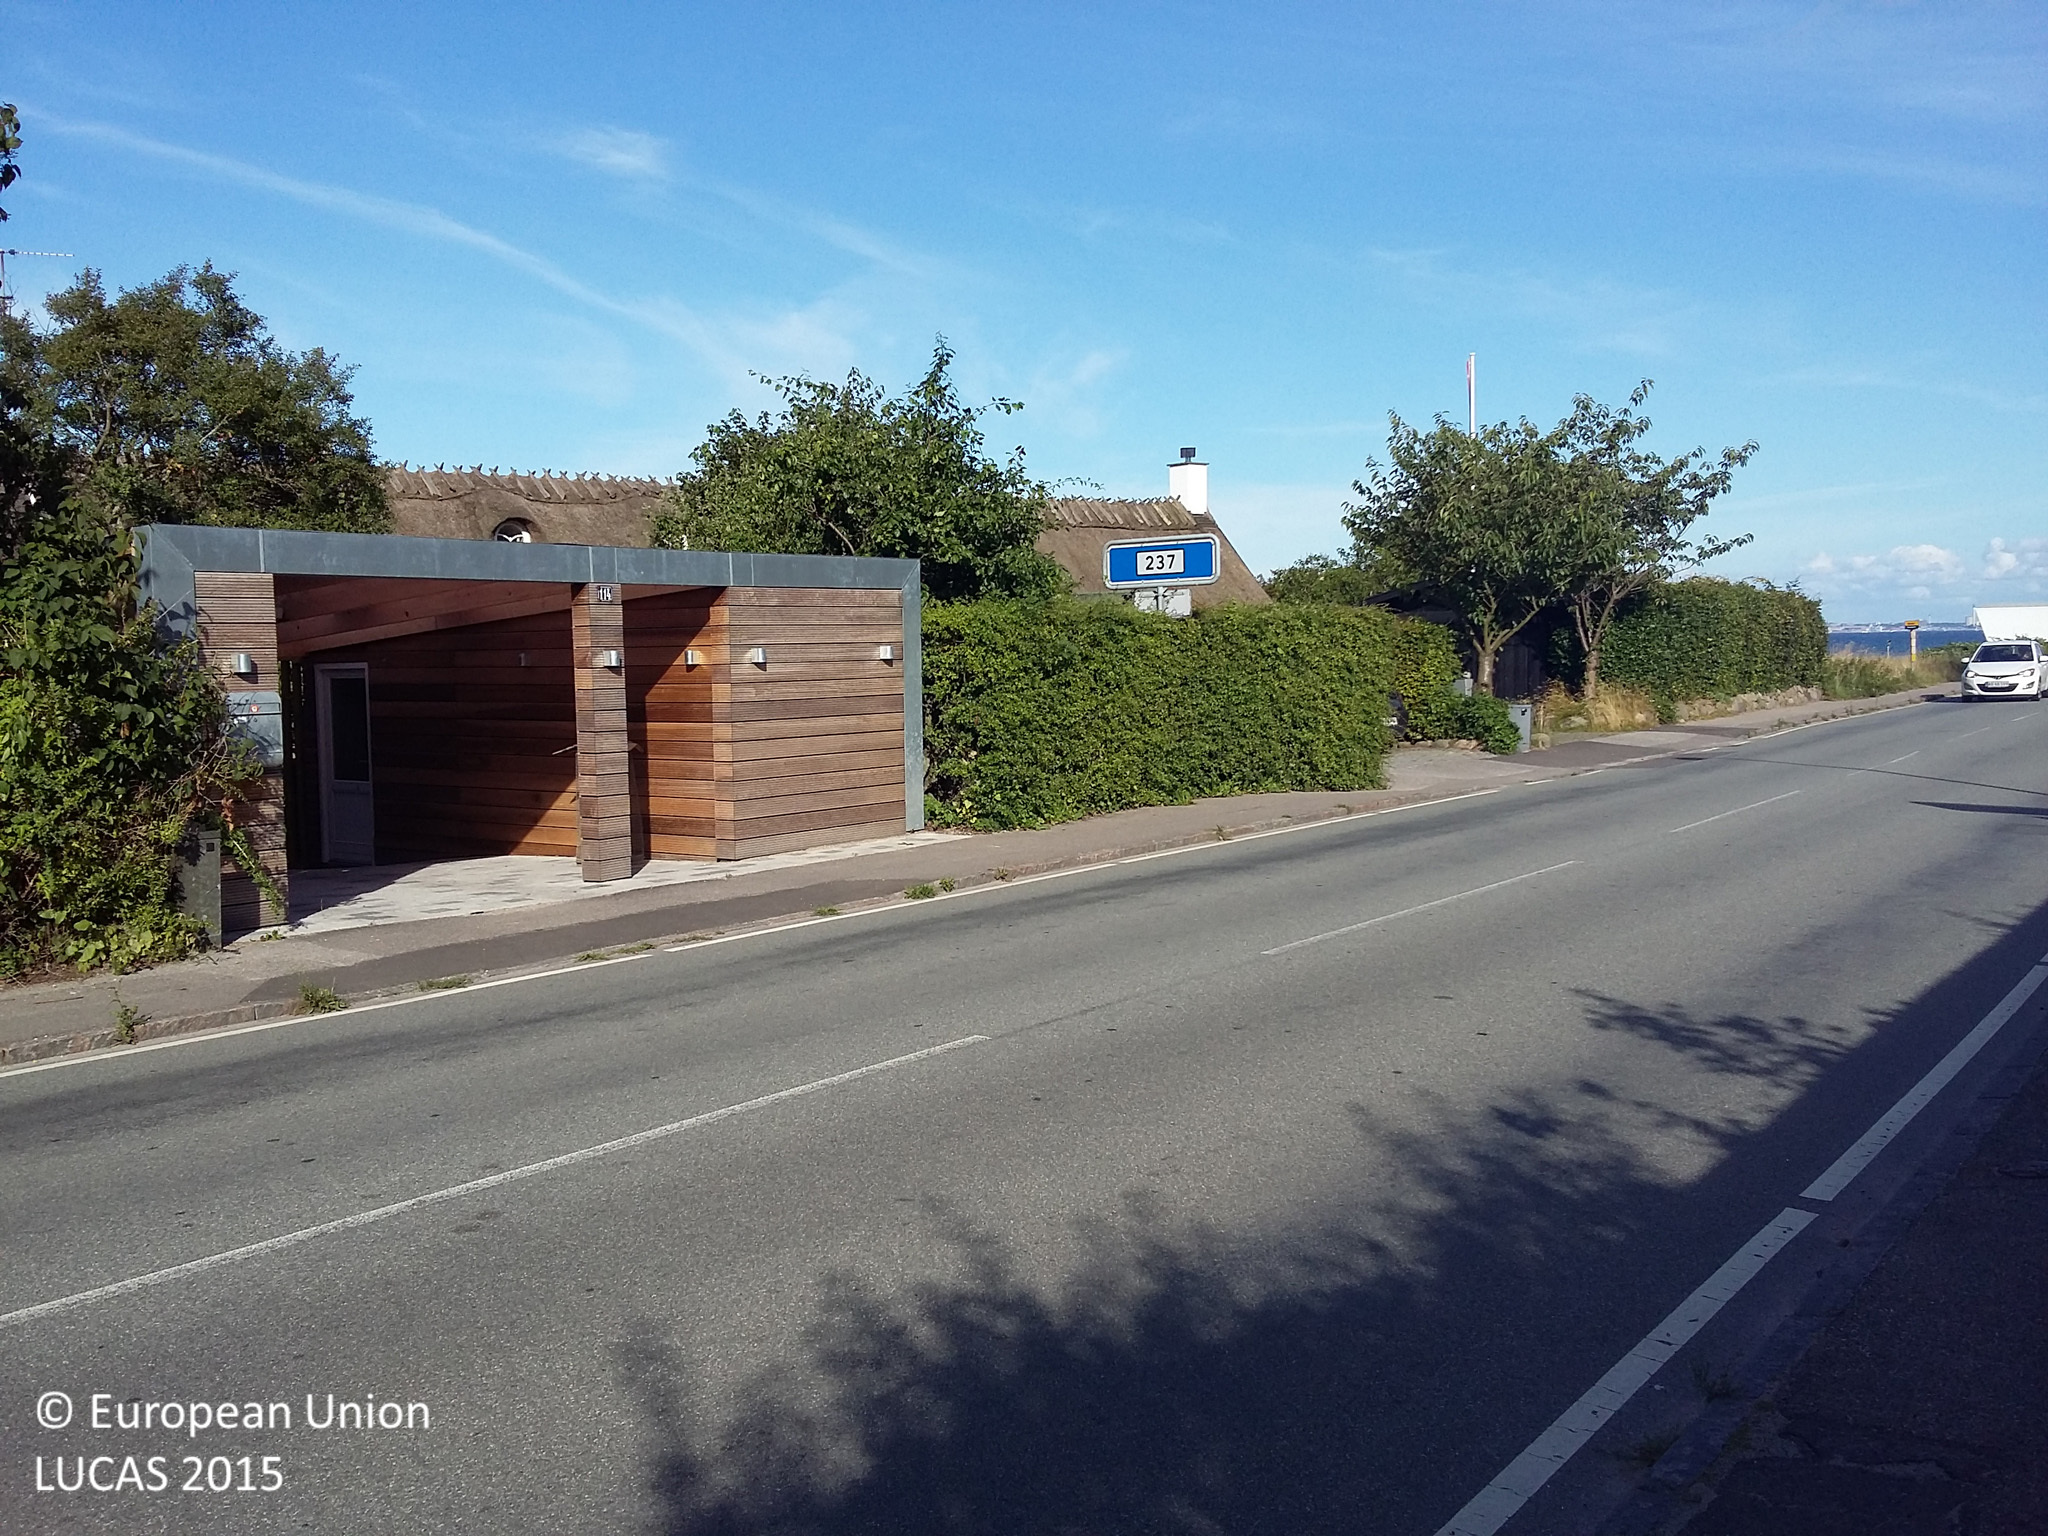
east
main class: Grassland
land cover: Grassland with sparse tree/shrub cover
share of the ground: > 75 %
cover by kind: herbaceous plants 85 %, shrubs 10 %, broadleaved forest trees 5 %
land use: Residential
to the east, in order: Grassland with sparse tree/shrub cover; Artificial constructions in urban areas; Broadleaved woodland; Sand; Rocks and stones; Transitional water bodies
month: July
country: DK
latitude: 56.0725
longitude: 12.5520
